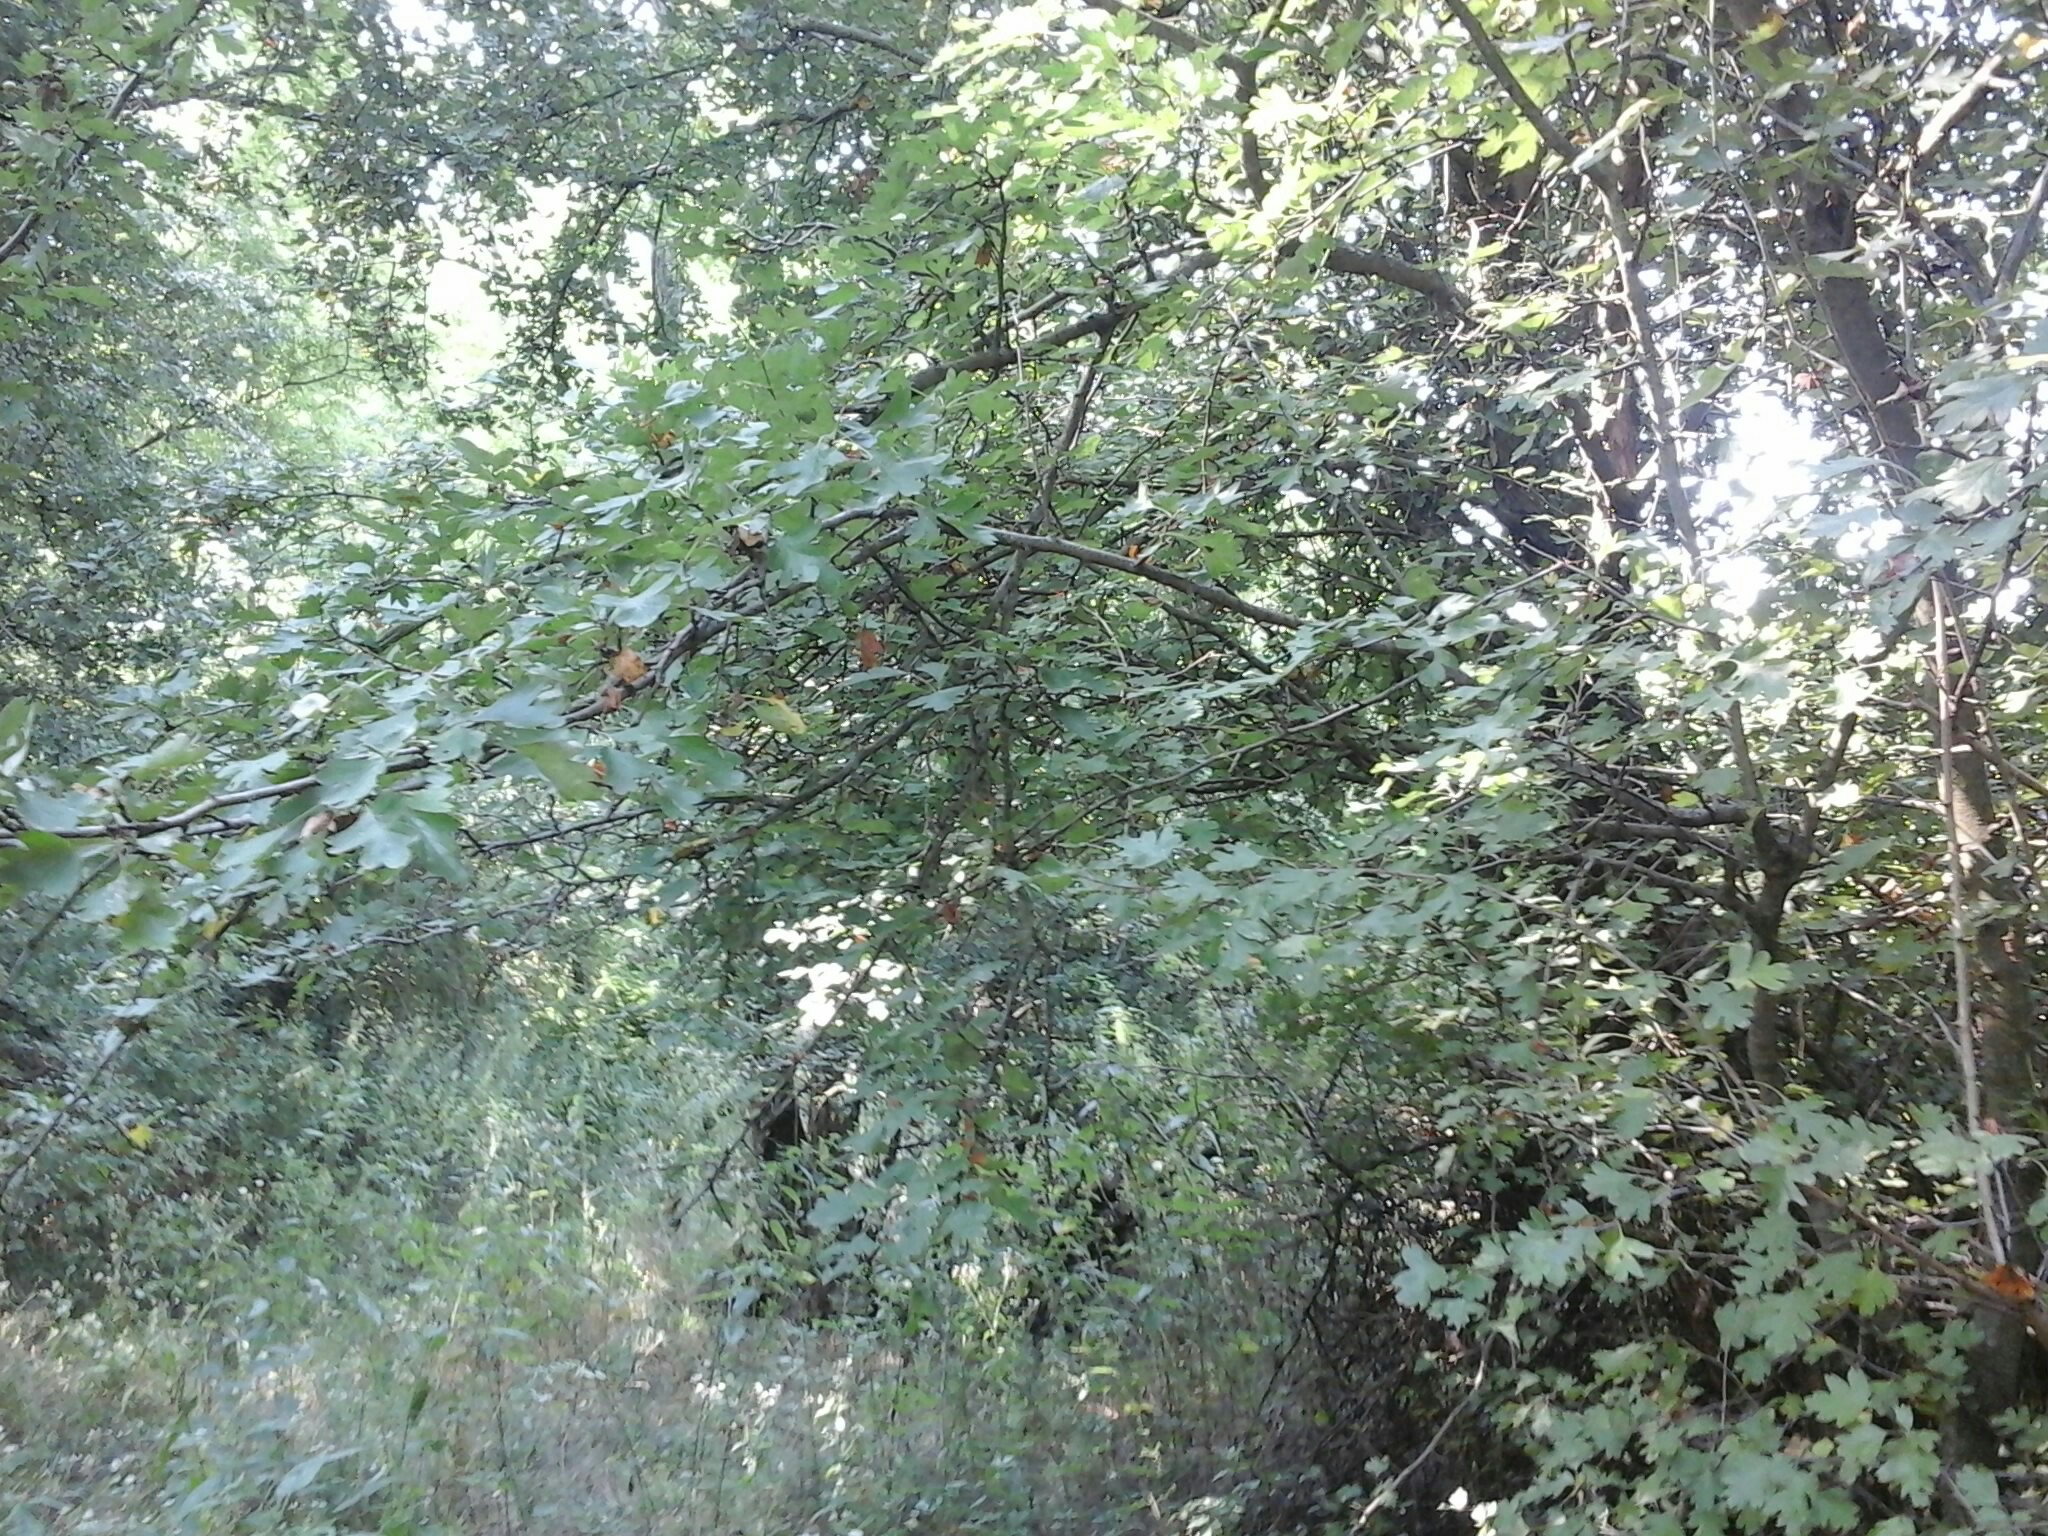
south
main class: Woodland
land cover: Broadleaved woodland
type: mesophytic deciduous forest
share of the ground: > 75 %
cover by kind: broadleaved forest trees 95 %, herbaceous plants 5 %
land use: Forestry
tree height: > 5 m
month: August
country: HU
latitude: 47.3978
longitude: 17.8933
